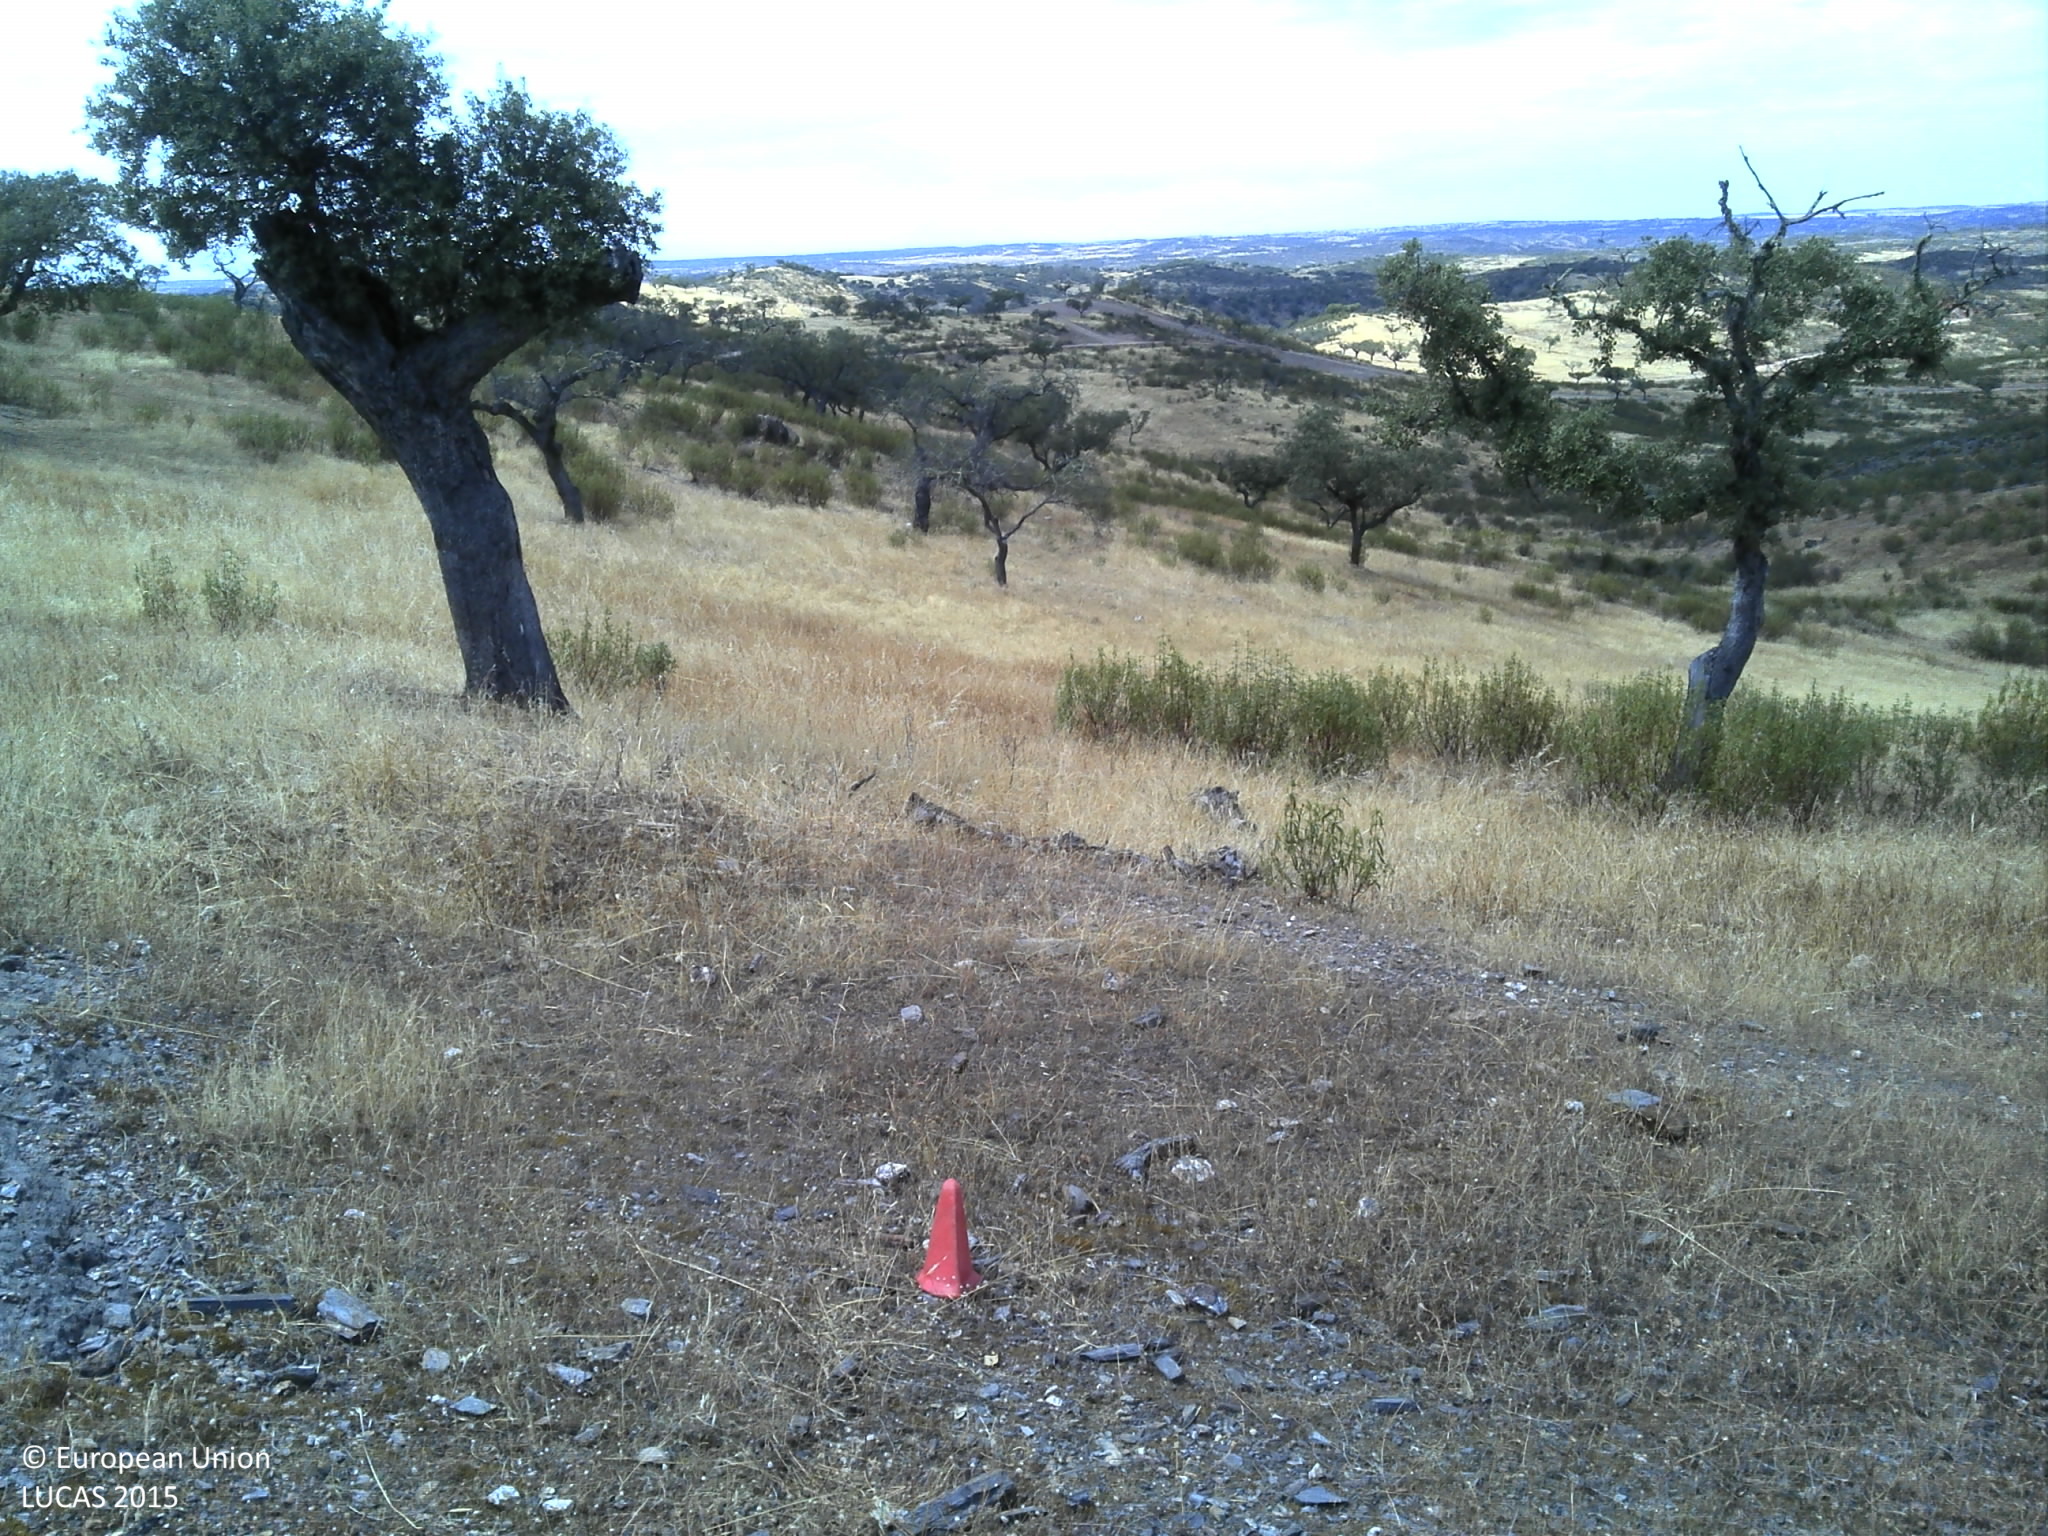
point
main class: Grassland
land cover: Grassland with sparse tree/shrub cover
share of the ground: 50 - 75 %
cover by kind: herbaceous plants 60 %, unconsolidated bare surface 30 %, broadleaved forest trees 5 %, shrubs 5 %
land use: Agriculture (excluding fallow land and kitchen gardens)
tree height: < 5 m
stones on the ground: < 10 %
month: July
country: PT
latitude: 38.1156
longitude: -7.1570
